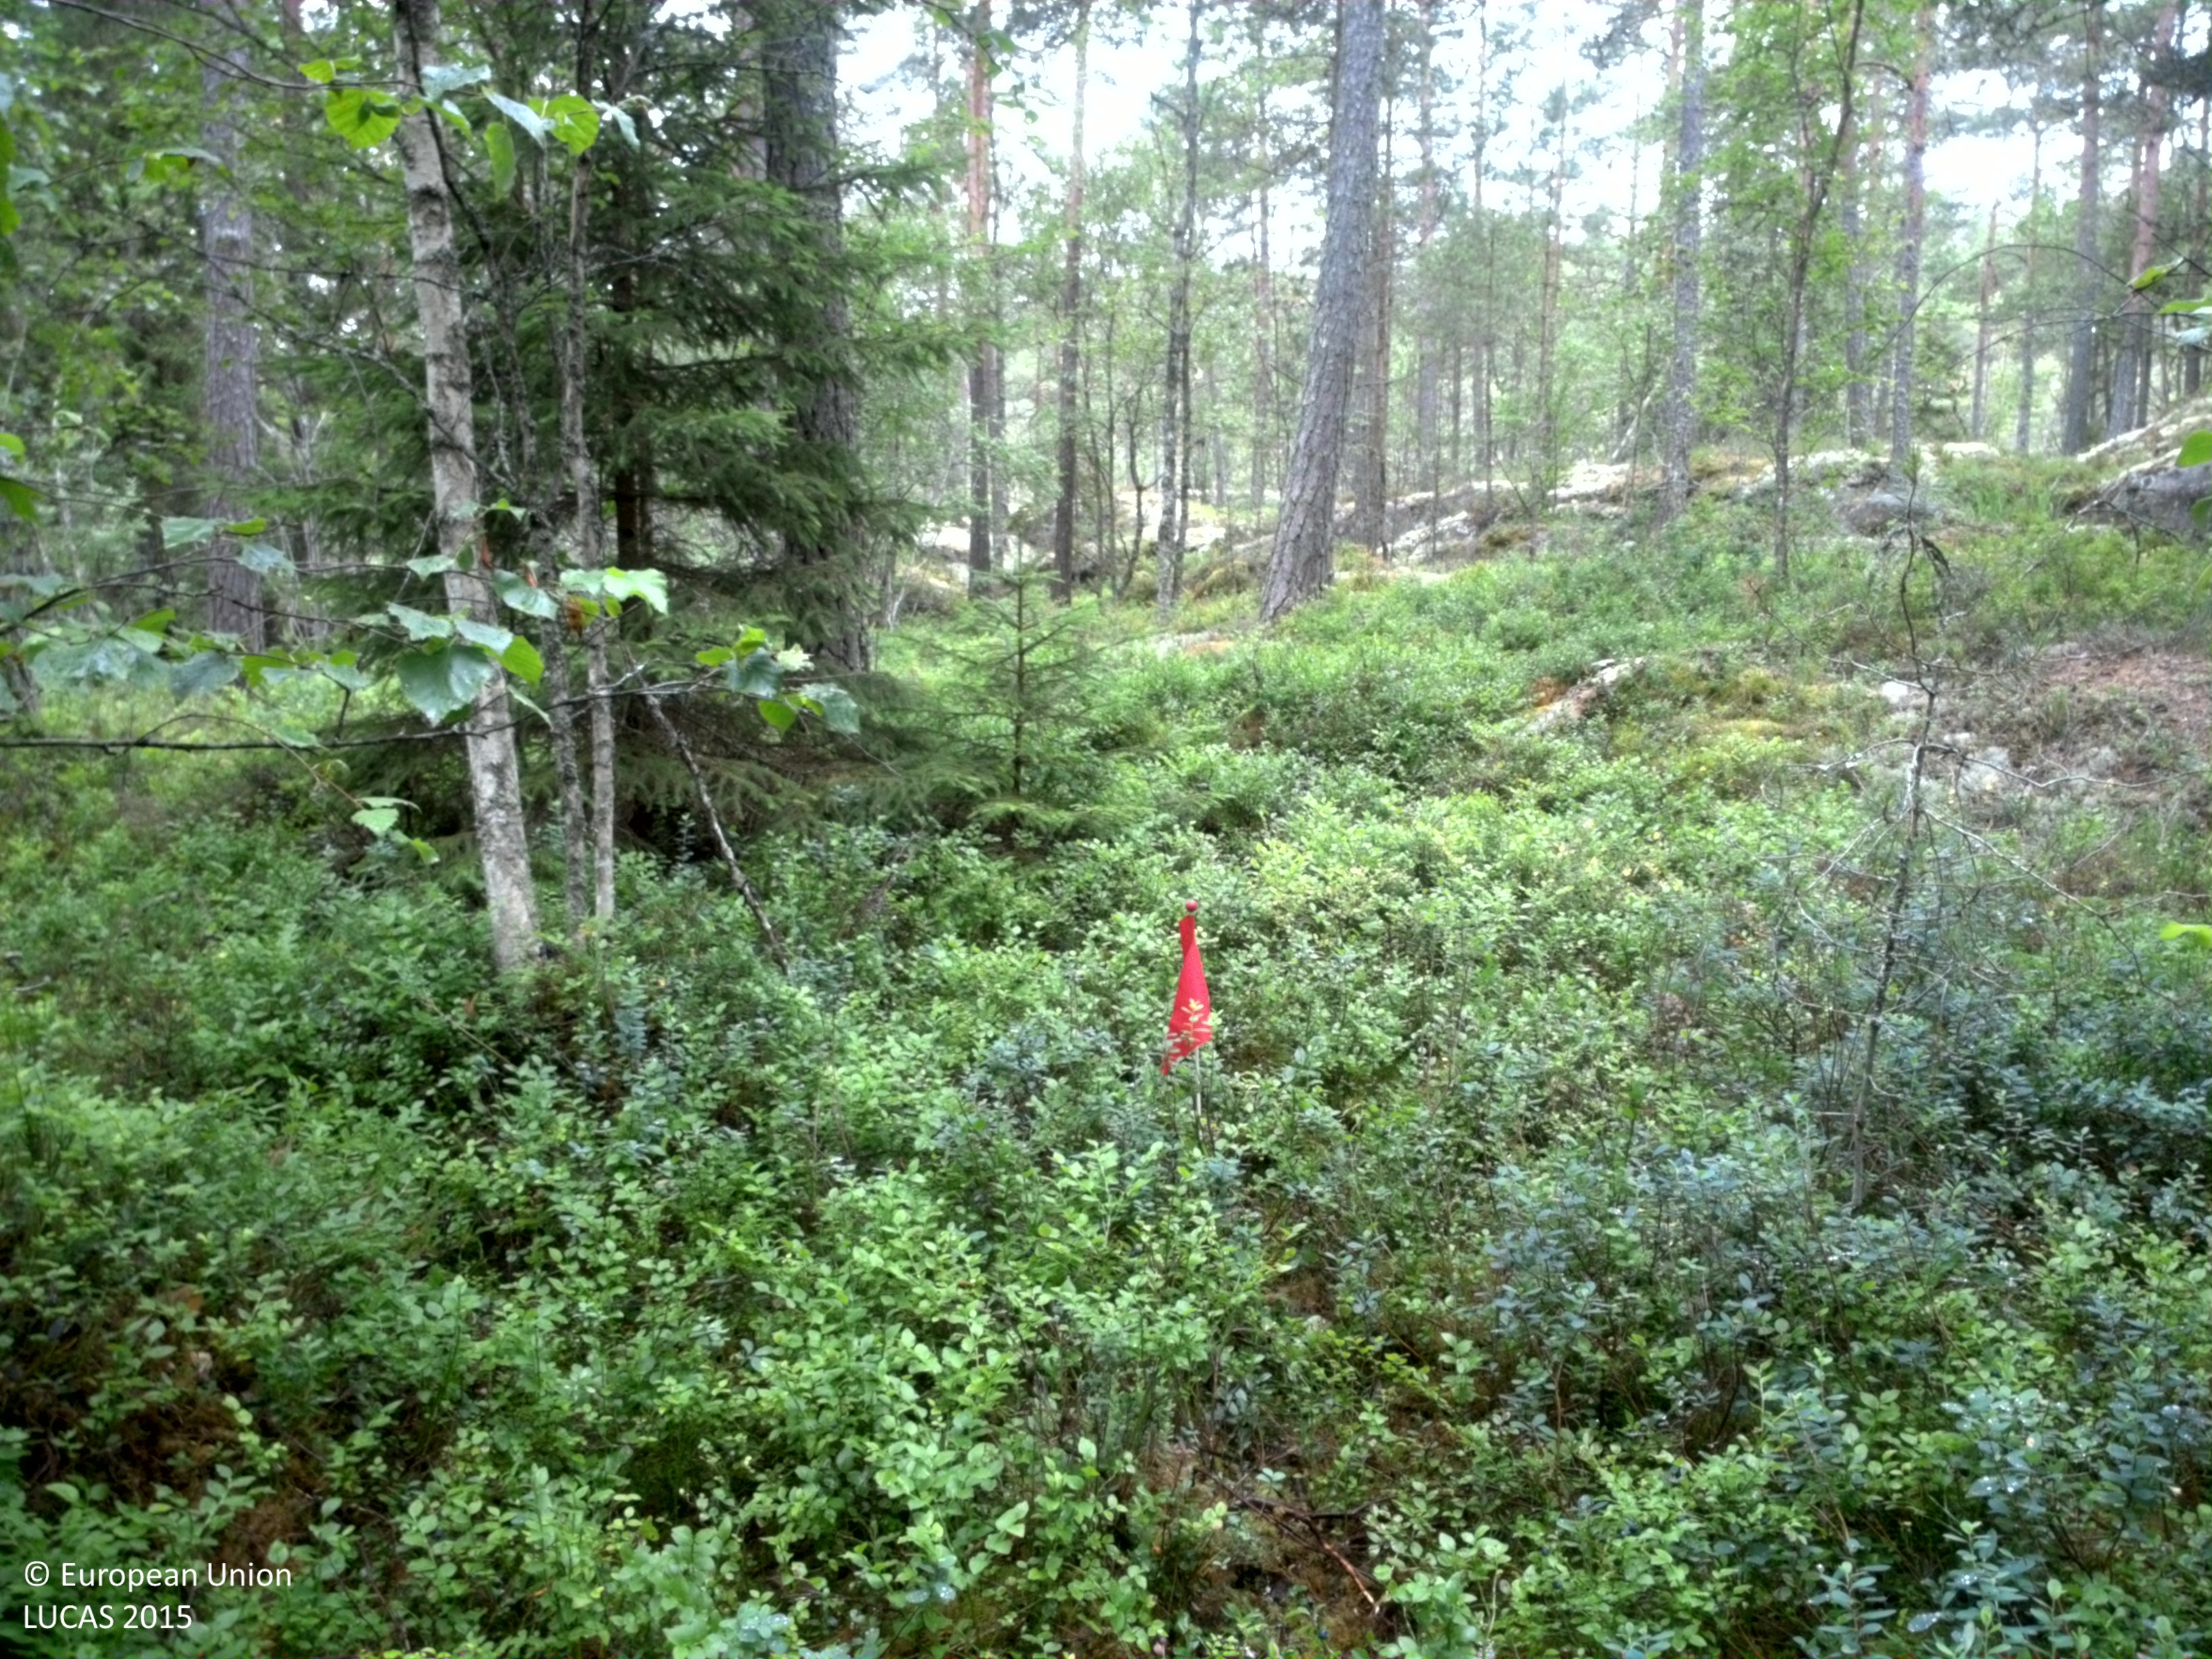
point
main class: Woodland
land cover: Pine dominated coniferous woodland
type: boreal forest
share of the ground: 50 - 75 %
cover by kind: coniferous forest trees 65 %, shrubs 20 %, lichens and mosses 10 %, broadleaved forest trees 5 %
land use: Forestry
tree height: > 5 m
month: July
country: SE
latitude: 59.3670
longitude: 13.3179
